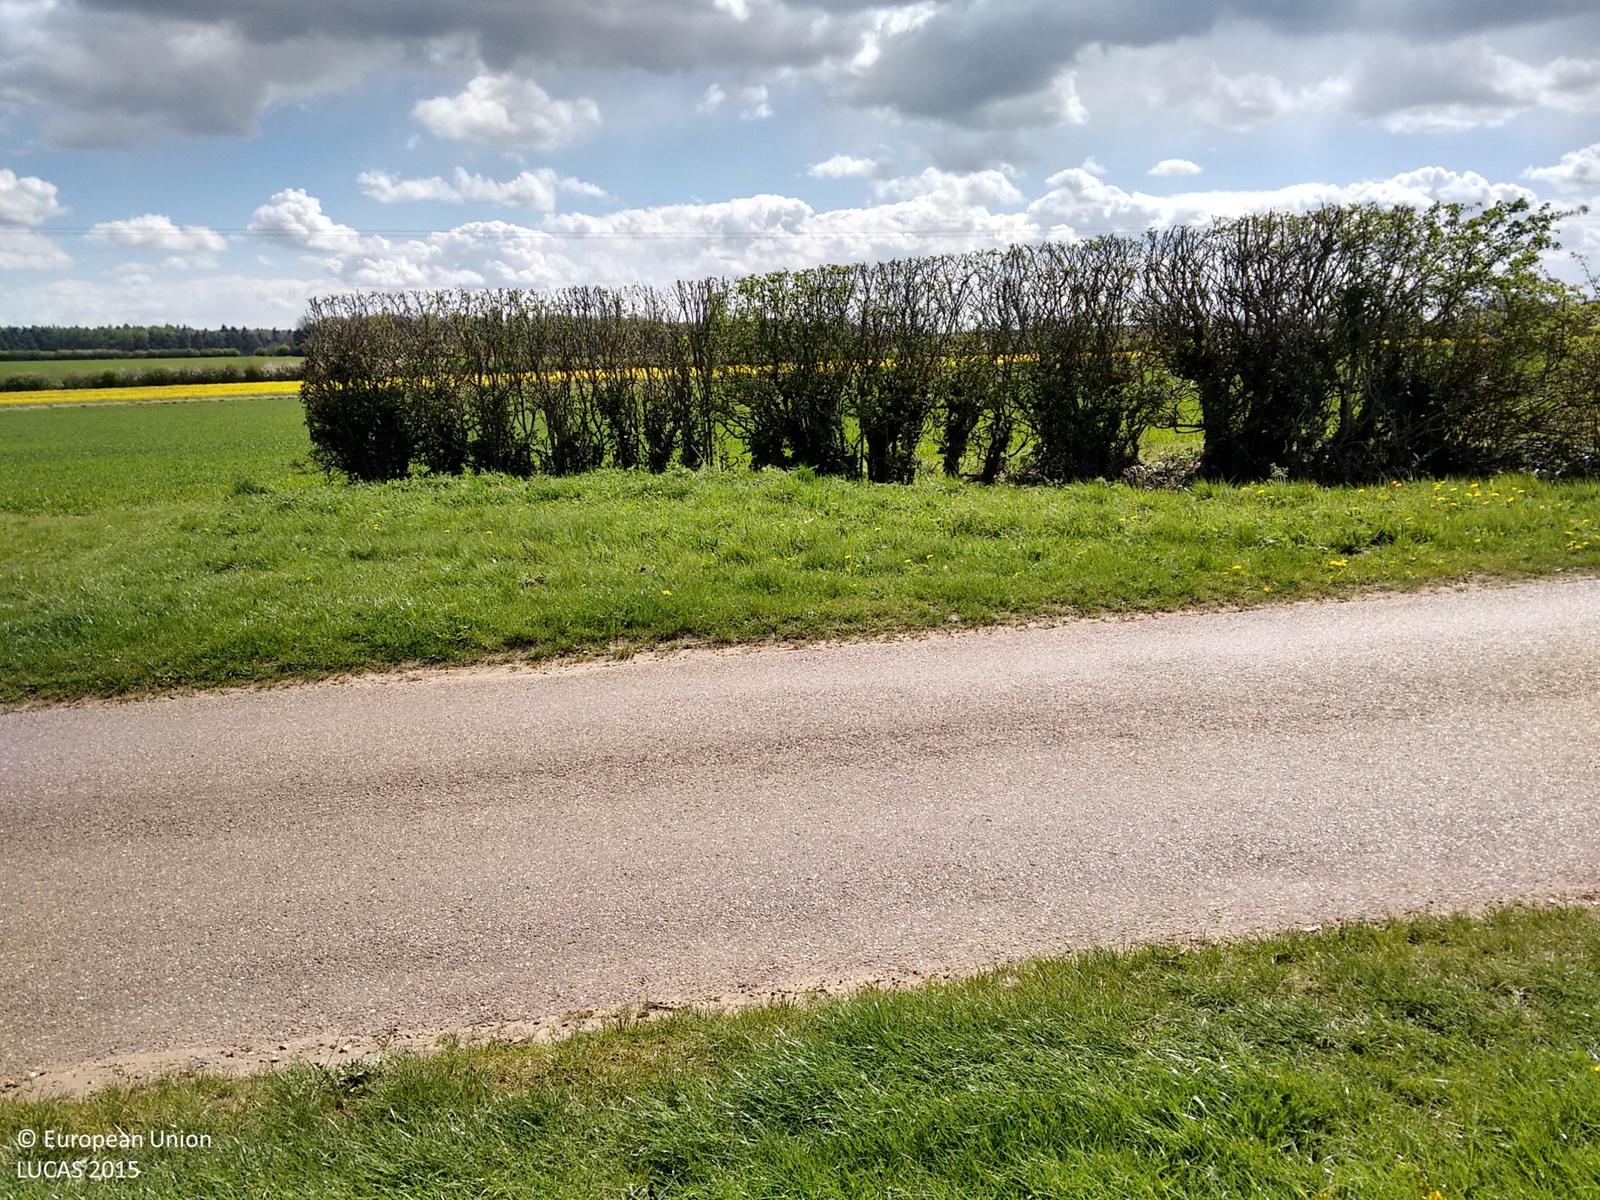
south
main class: Grassland
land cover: Grassland without tree/shrub cover
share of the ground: > 75 %
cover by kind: herbaceous plants 100 %
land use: Road transport
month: April
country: GB
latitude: 53.1575
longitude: -0.1281
